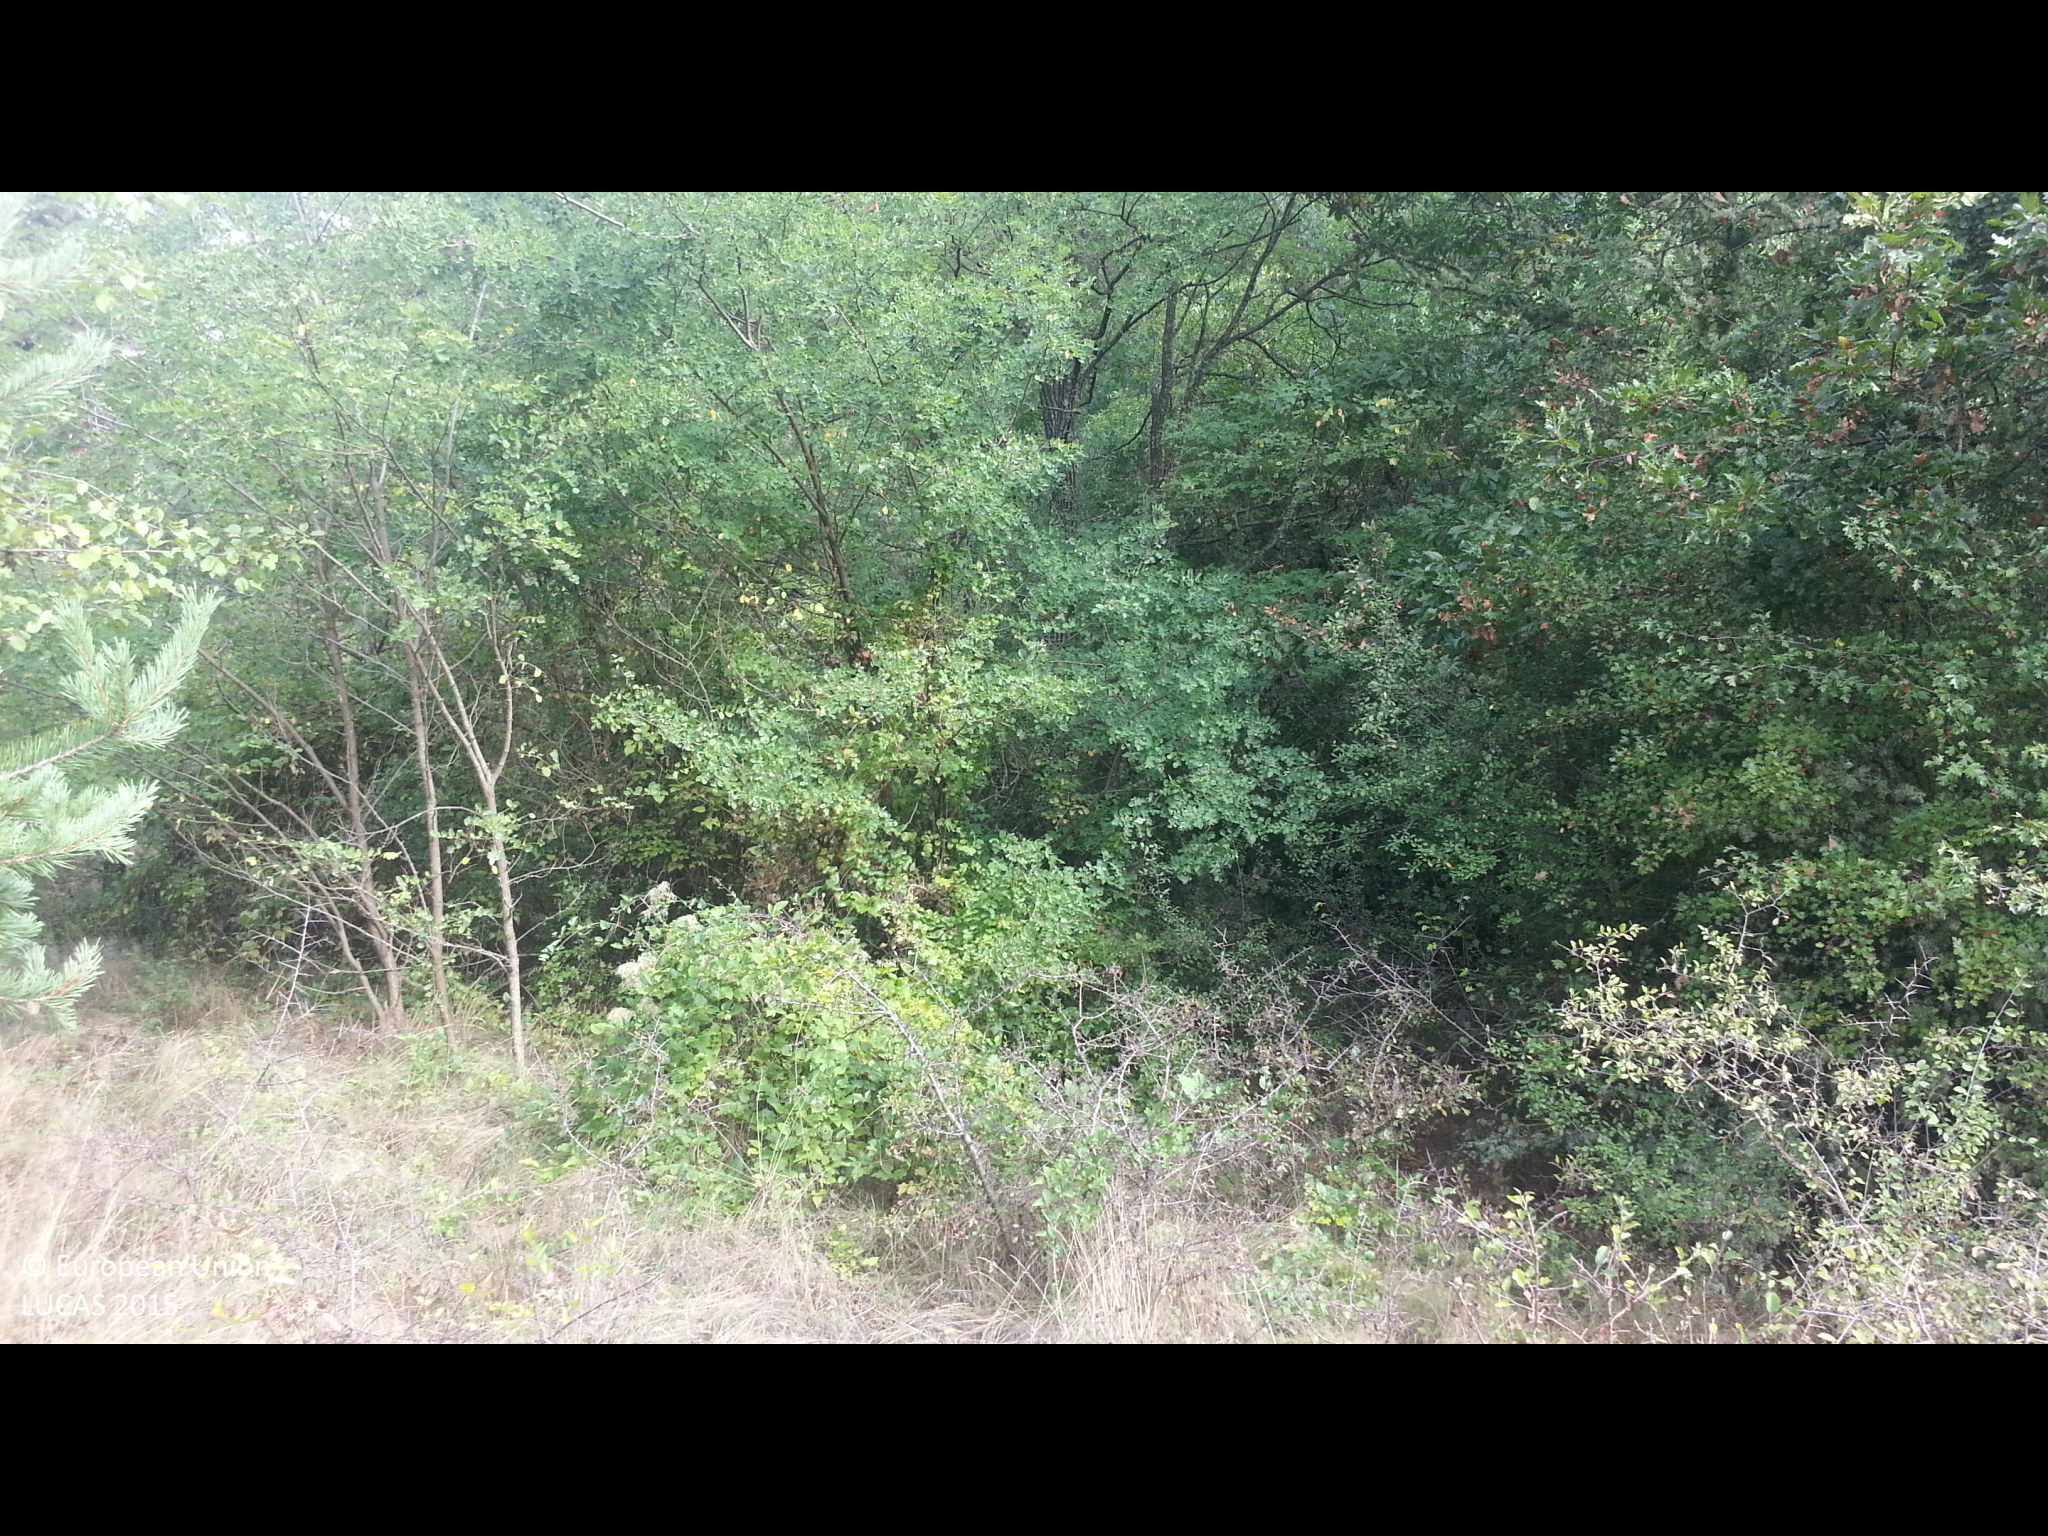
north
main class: Woodland
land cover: Other coniferous woodland
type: hemiboreal forest and nemoral coniferous forest and mixed broadleaved-coniferous forest
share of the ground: > 75 %
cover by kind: coniferous forest trees 100 %
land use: Forestry
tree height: > 5 m
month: September
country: BG
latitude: 42.5598
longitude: 22.5807
